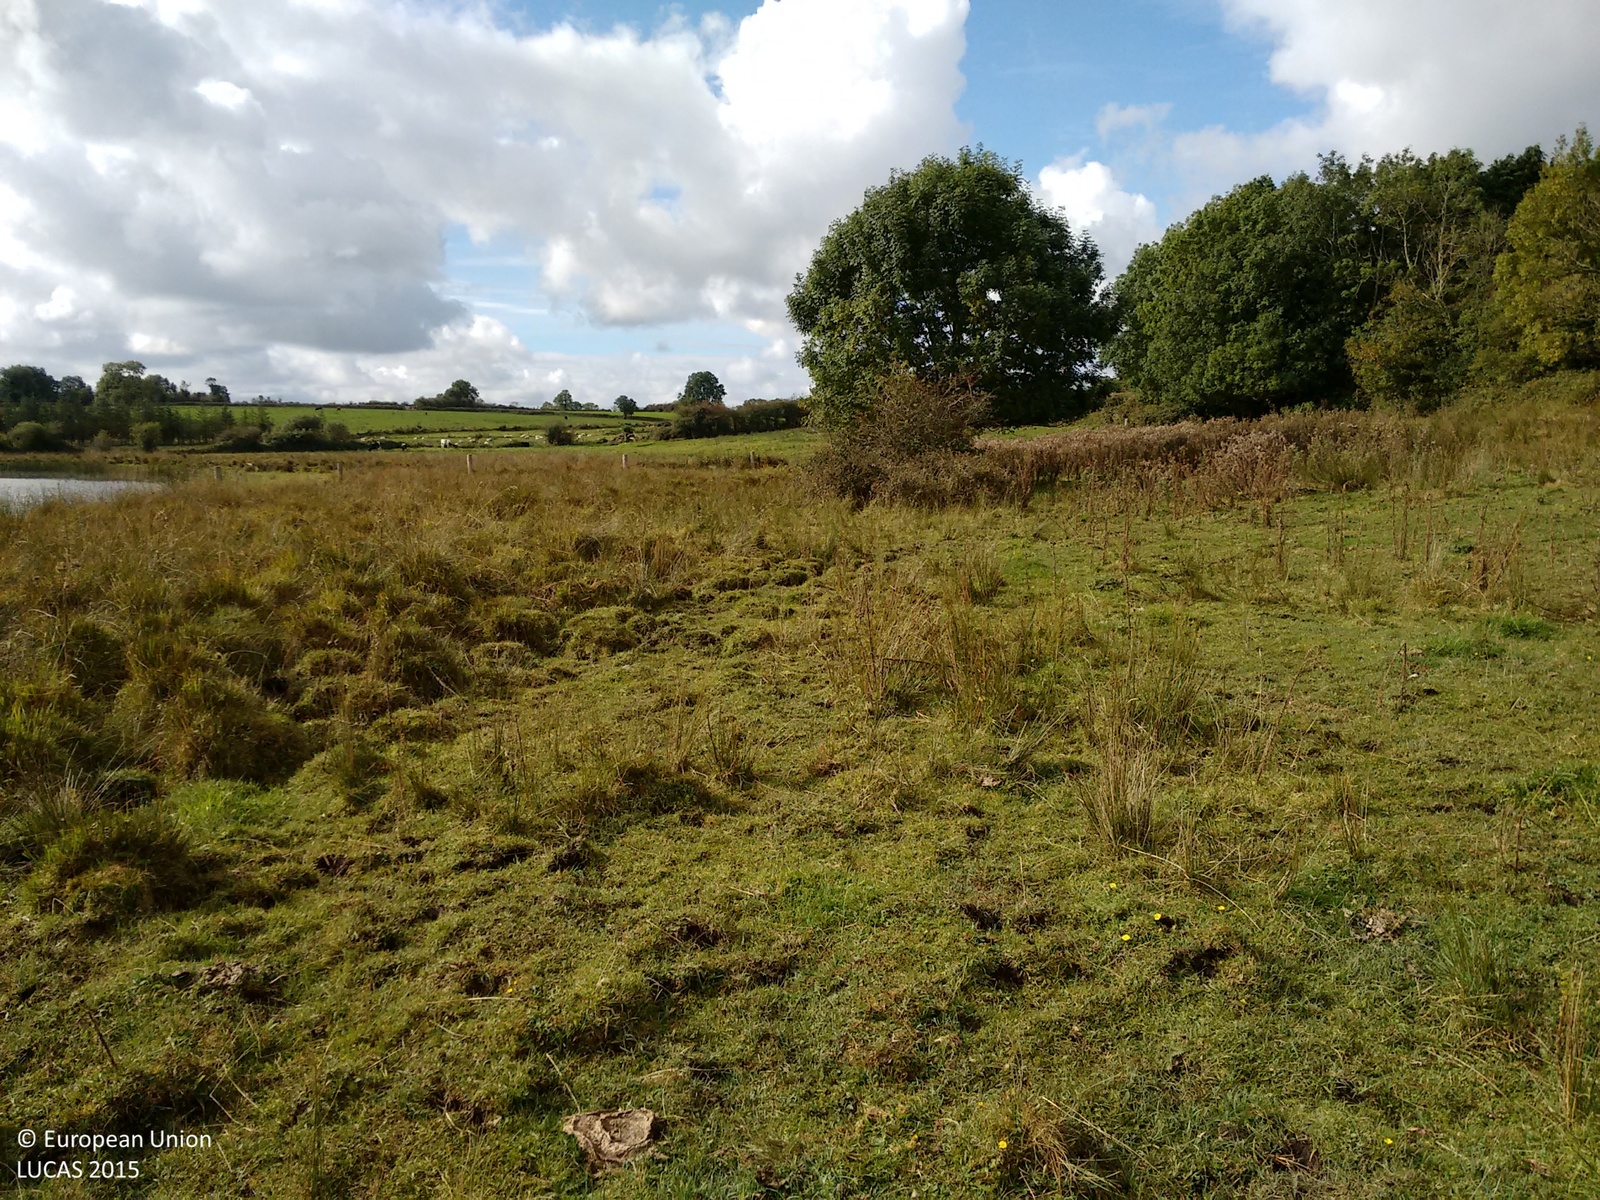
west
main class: Grassland
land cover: Grassland without tree/shrub cover
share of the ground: > 75 %
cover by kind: herbaceous plants 100 %
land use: Agriculture (excluding fallow land and kitchen gardens)
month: October
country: IE
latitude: 53.8179
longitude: -8.1805
